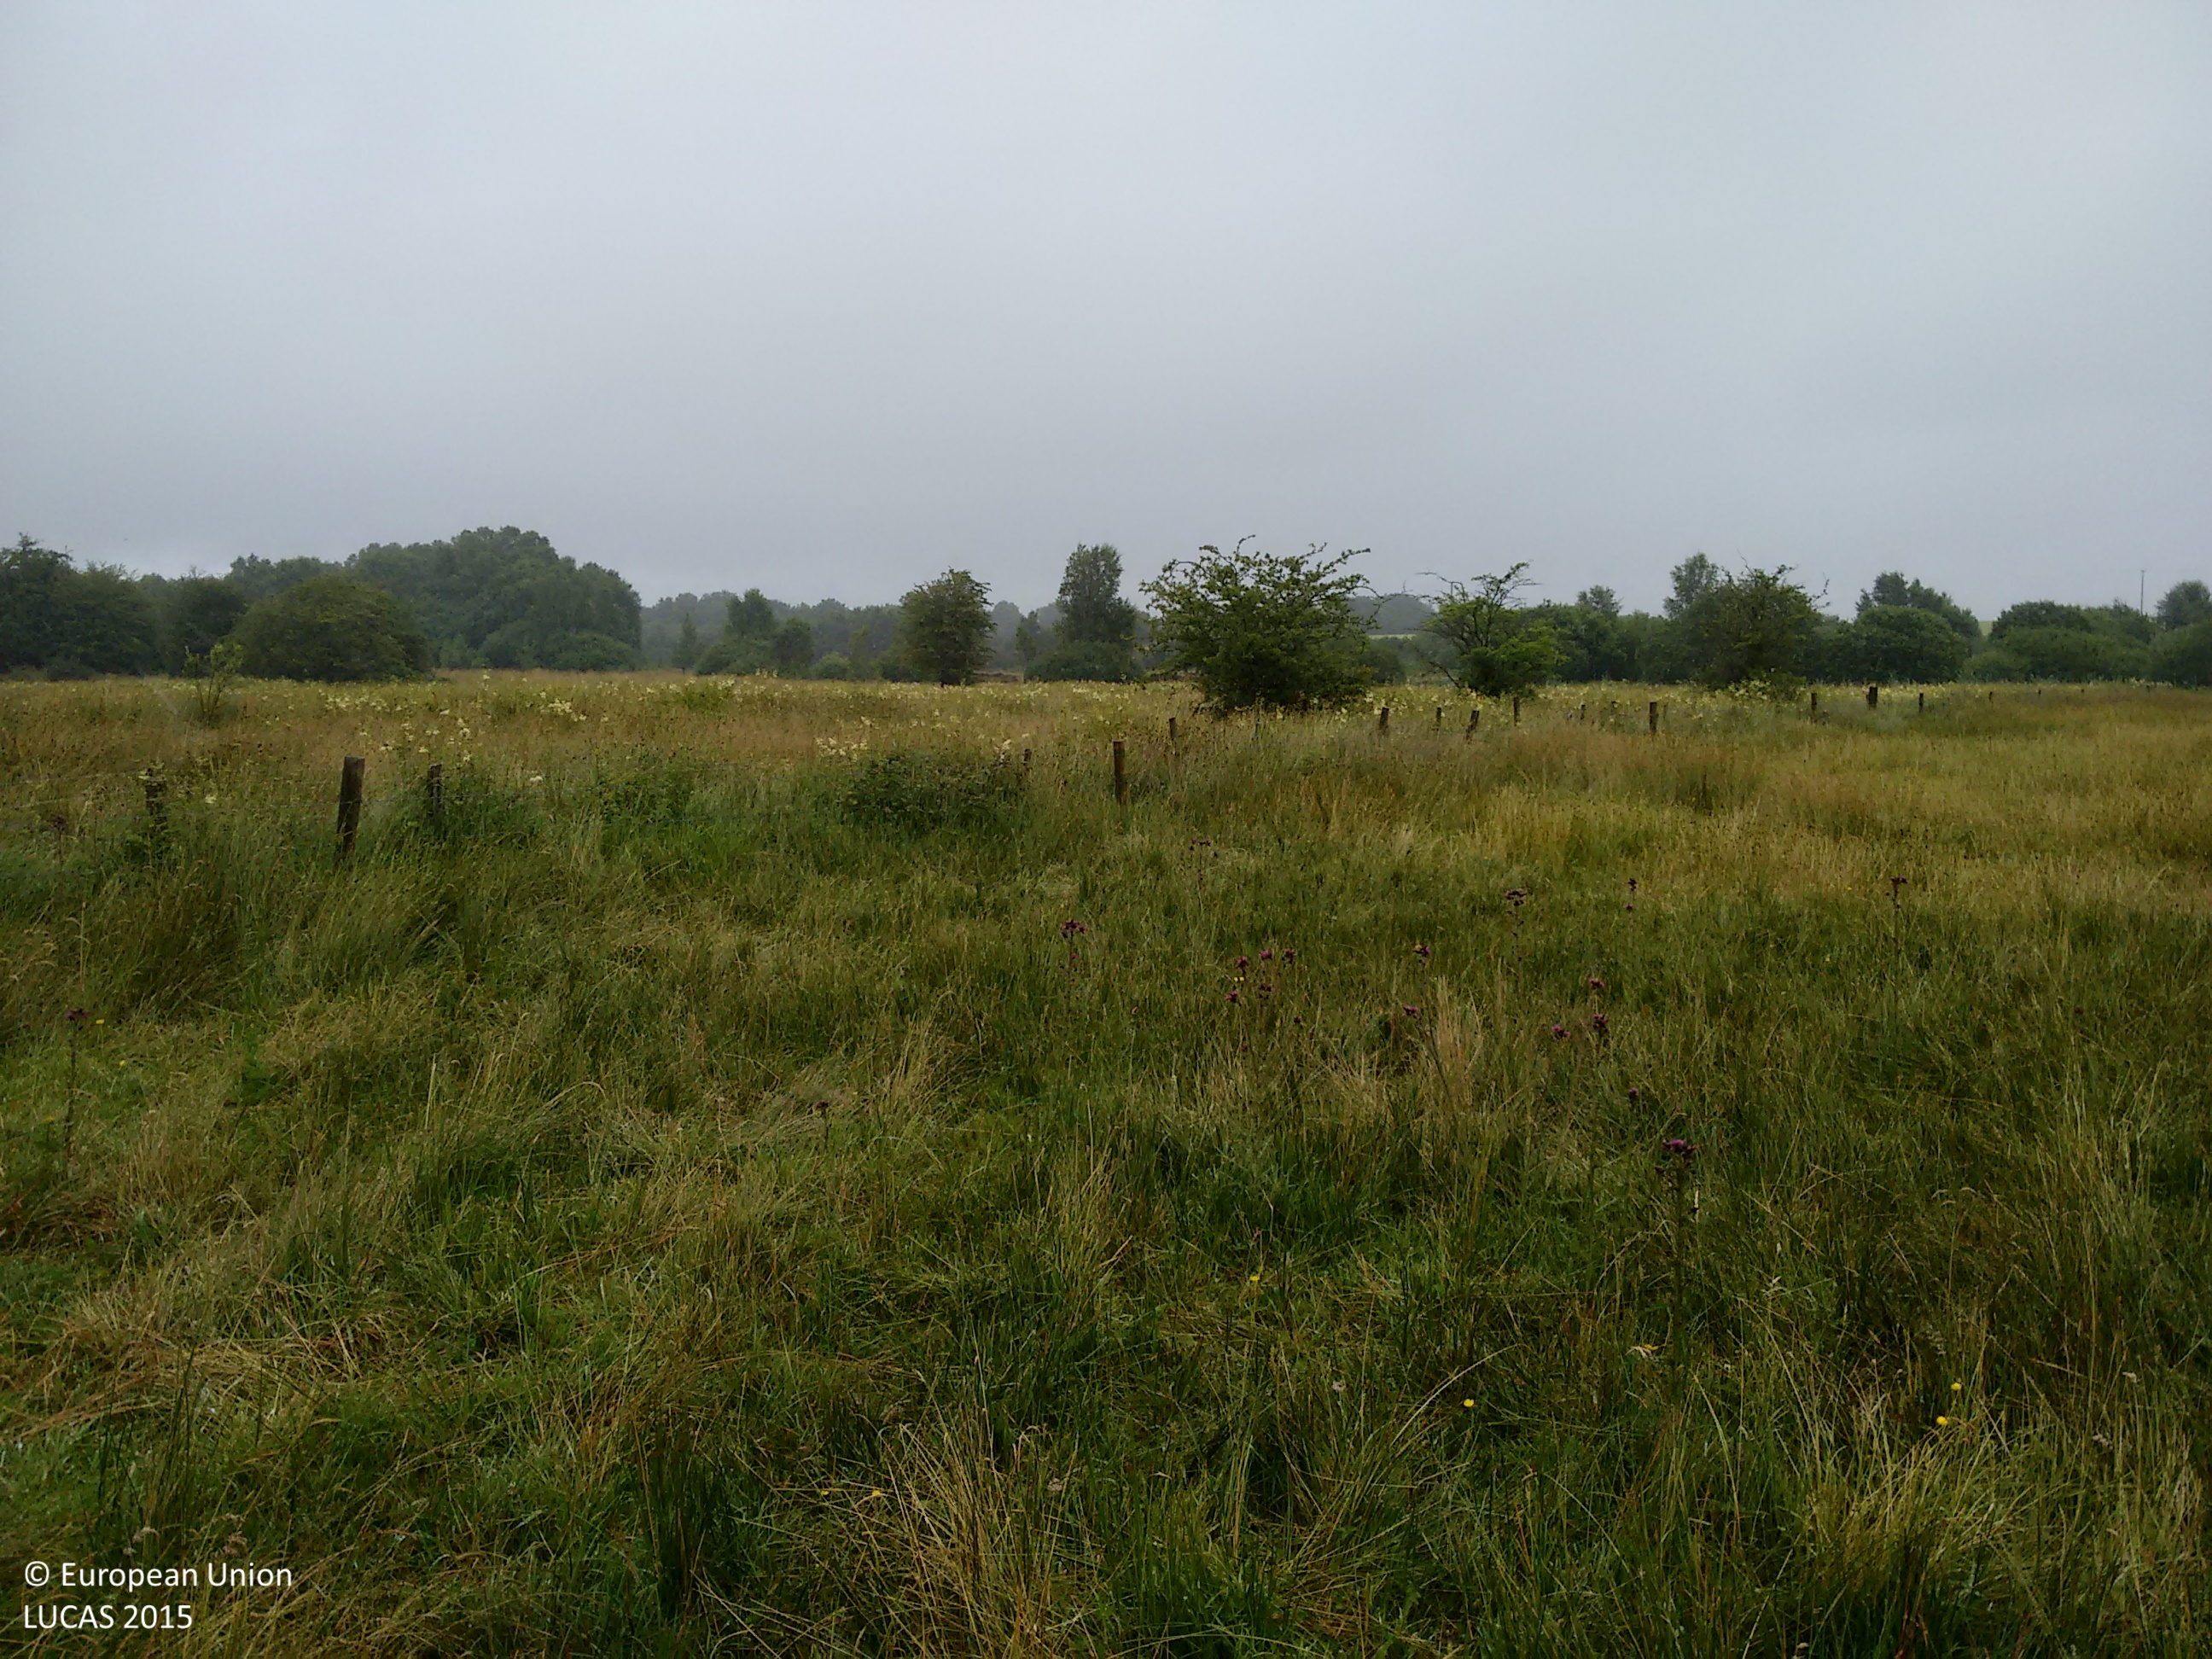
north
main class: Grassland
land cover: Grassland without tree/shrub cover
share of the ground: > 75 %
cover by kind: herbaceous plants 95 %, shrubs 5 %
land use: Agriculture (excluding fallow land and kitchen gardens)
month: July
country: IE
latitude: 53.6672
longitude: -7.8316
